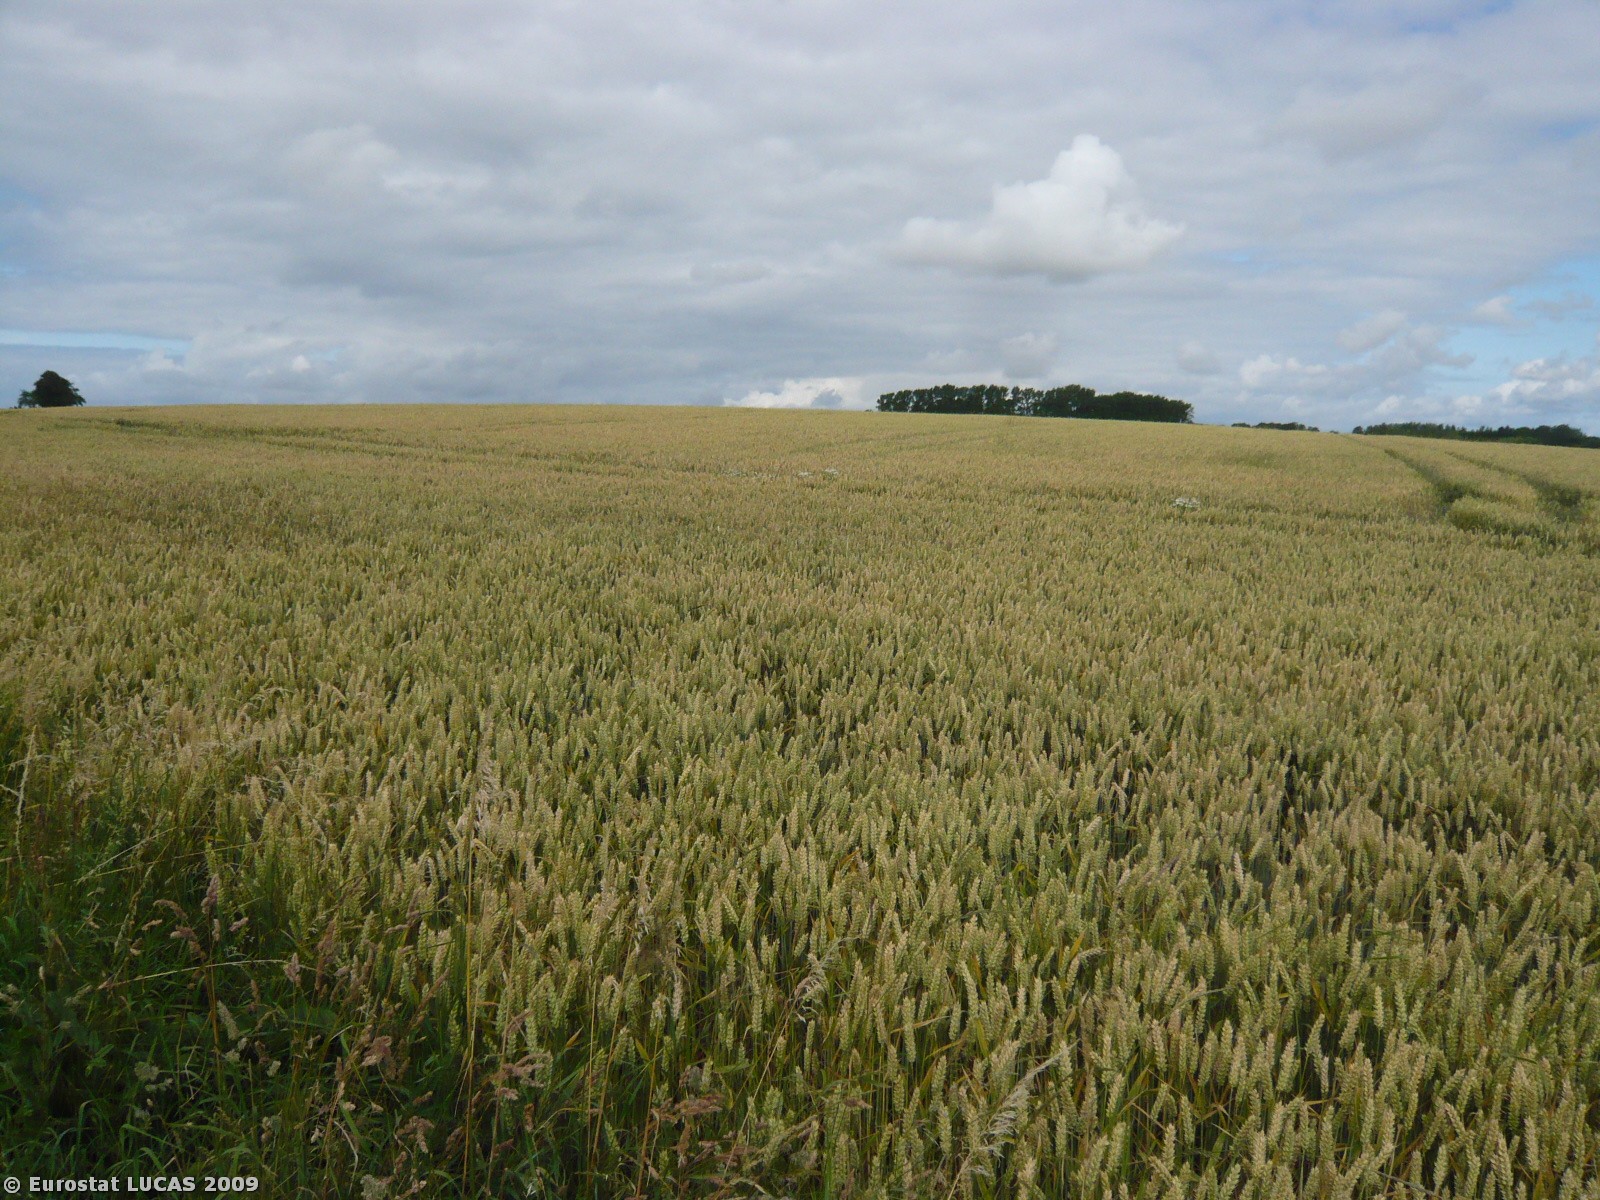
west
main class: Cropland
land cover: Common wheat
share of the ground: > 75 %
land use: Agriculture (excluding fallow land and kitchen gardens)
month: July
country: DK
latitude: 55.5884
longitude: 11.2523
